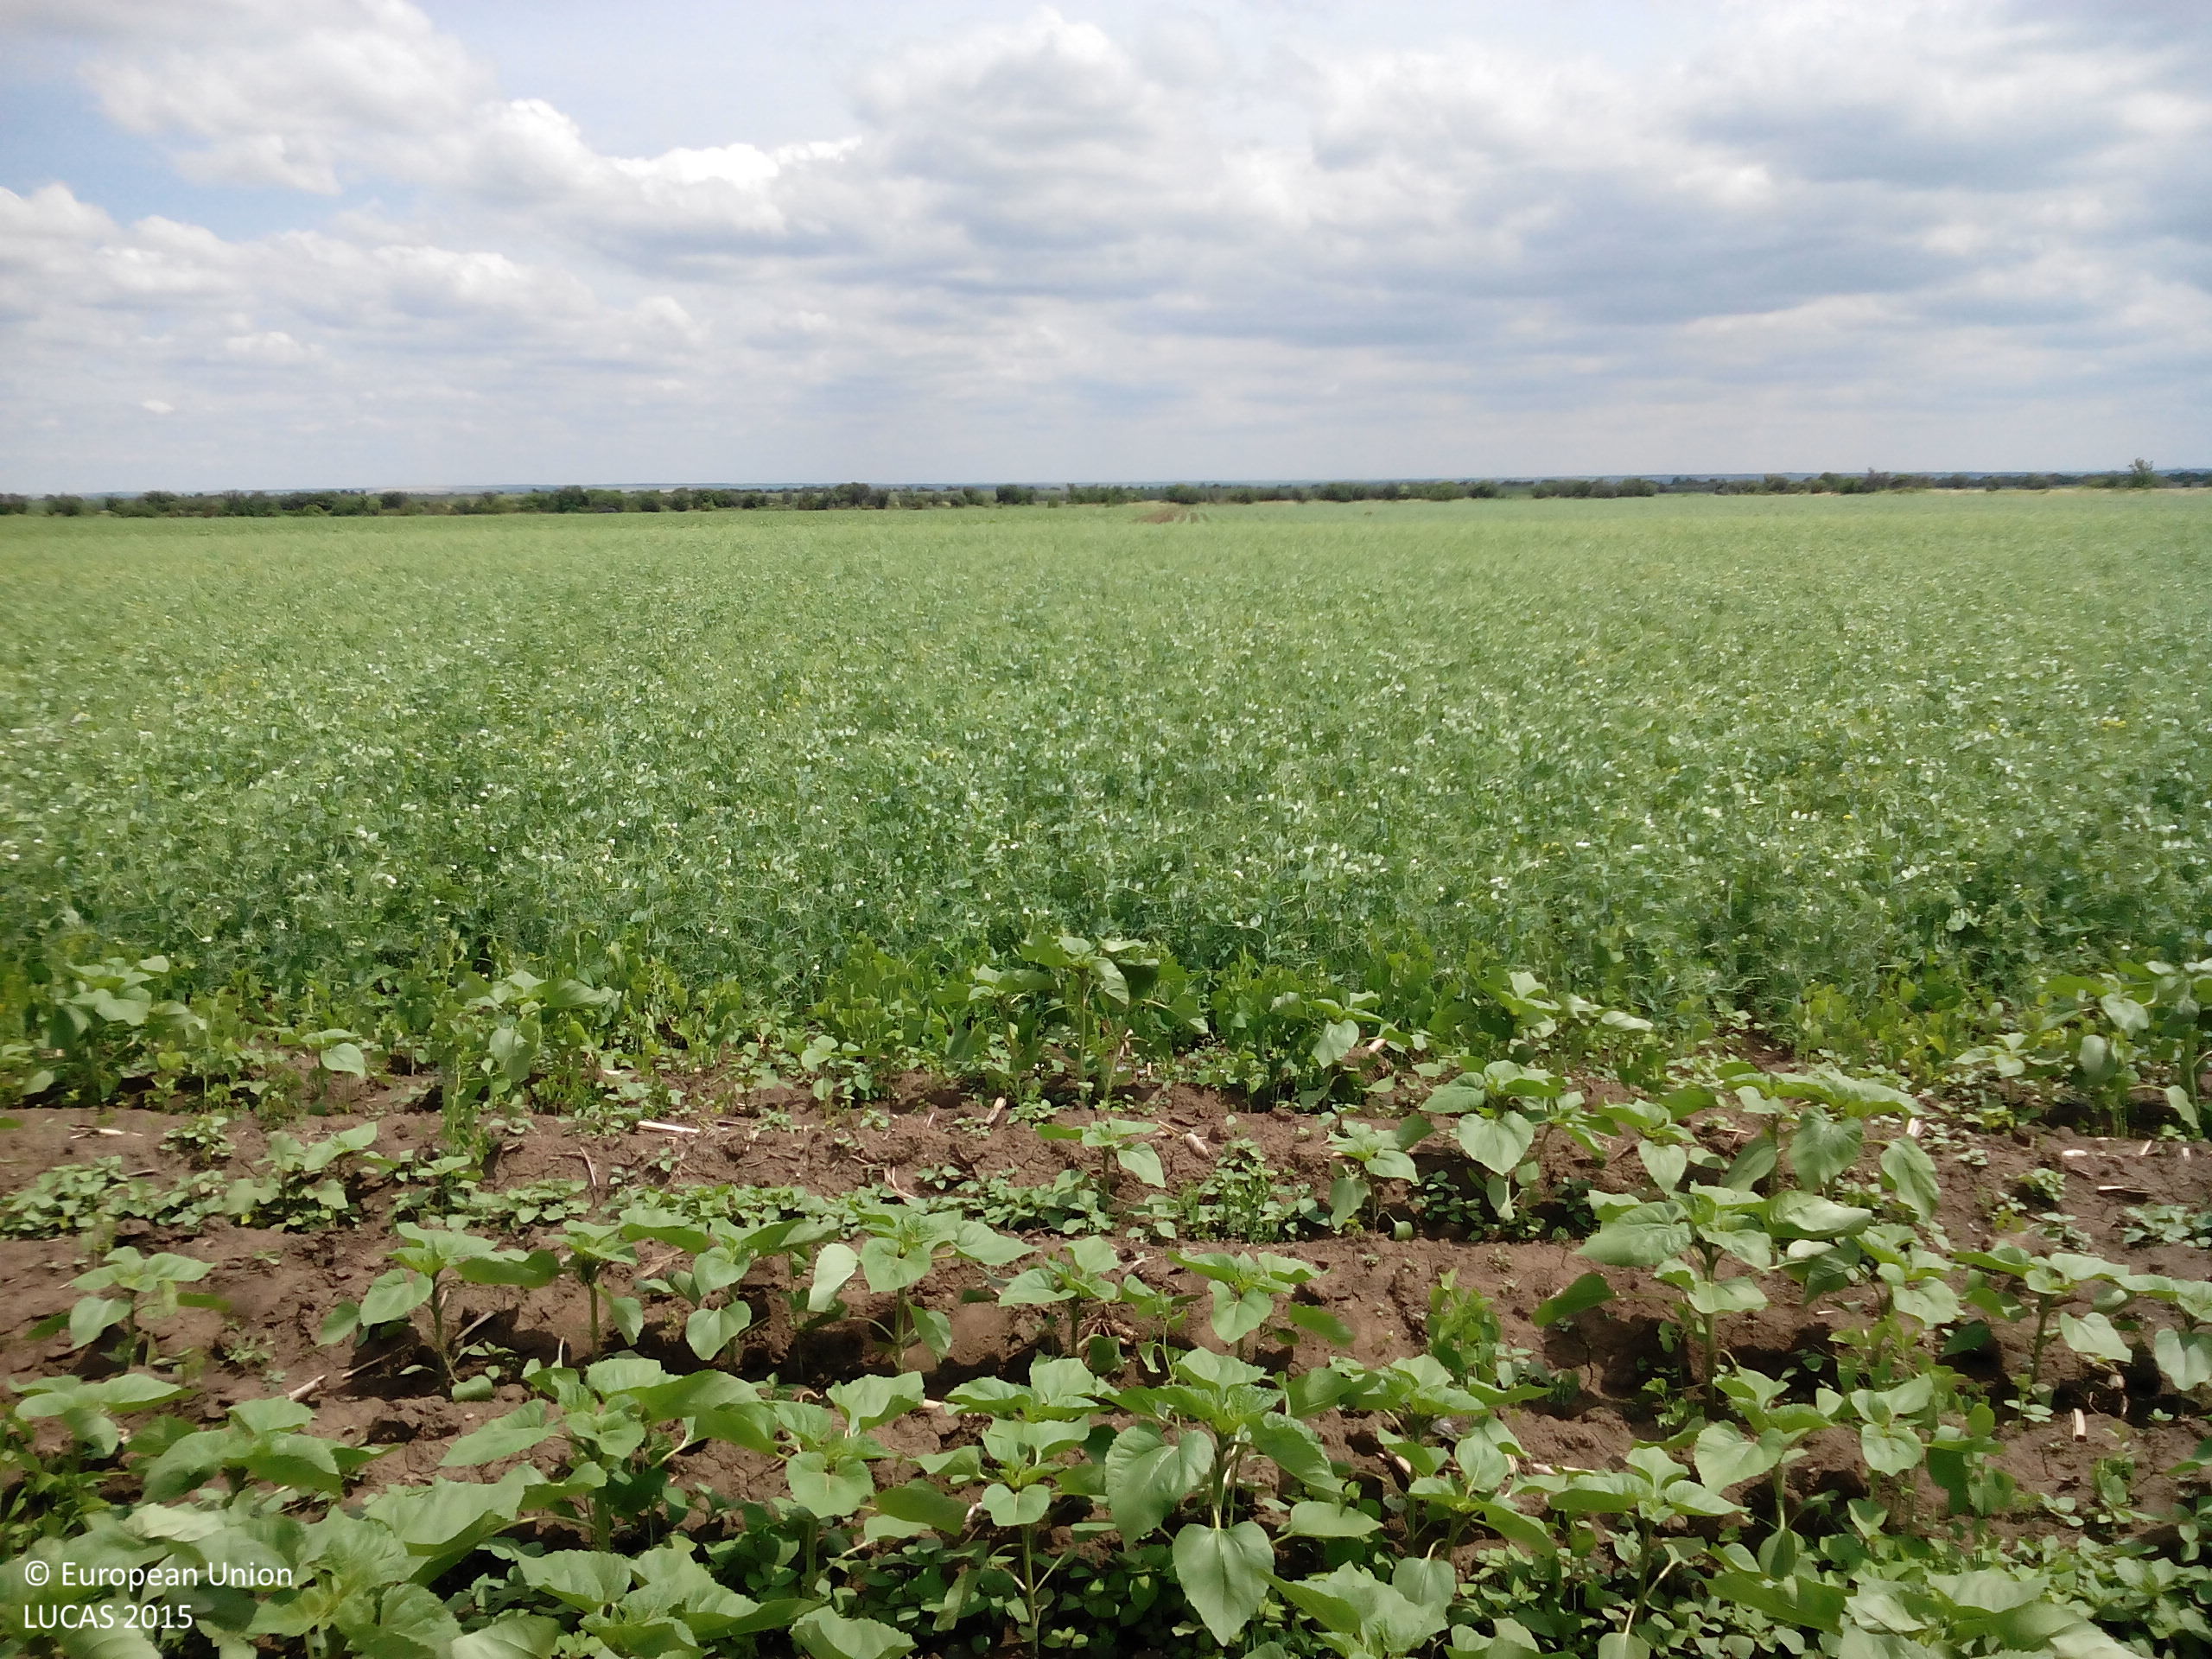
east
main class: Cropland
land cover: Sunflower
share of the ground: 50 - 75 %
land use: Agriculture (excluding fallow land and kitchen gardens)
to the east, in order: Sunflower; Other leguminous and mixtures for fodder; Sunflower
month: May
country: BG
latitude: 43.5043
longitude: 24.1428
